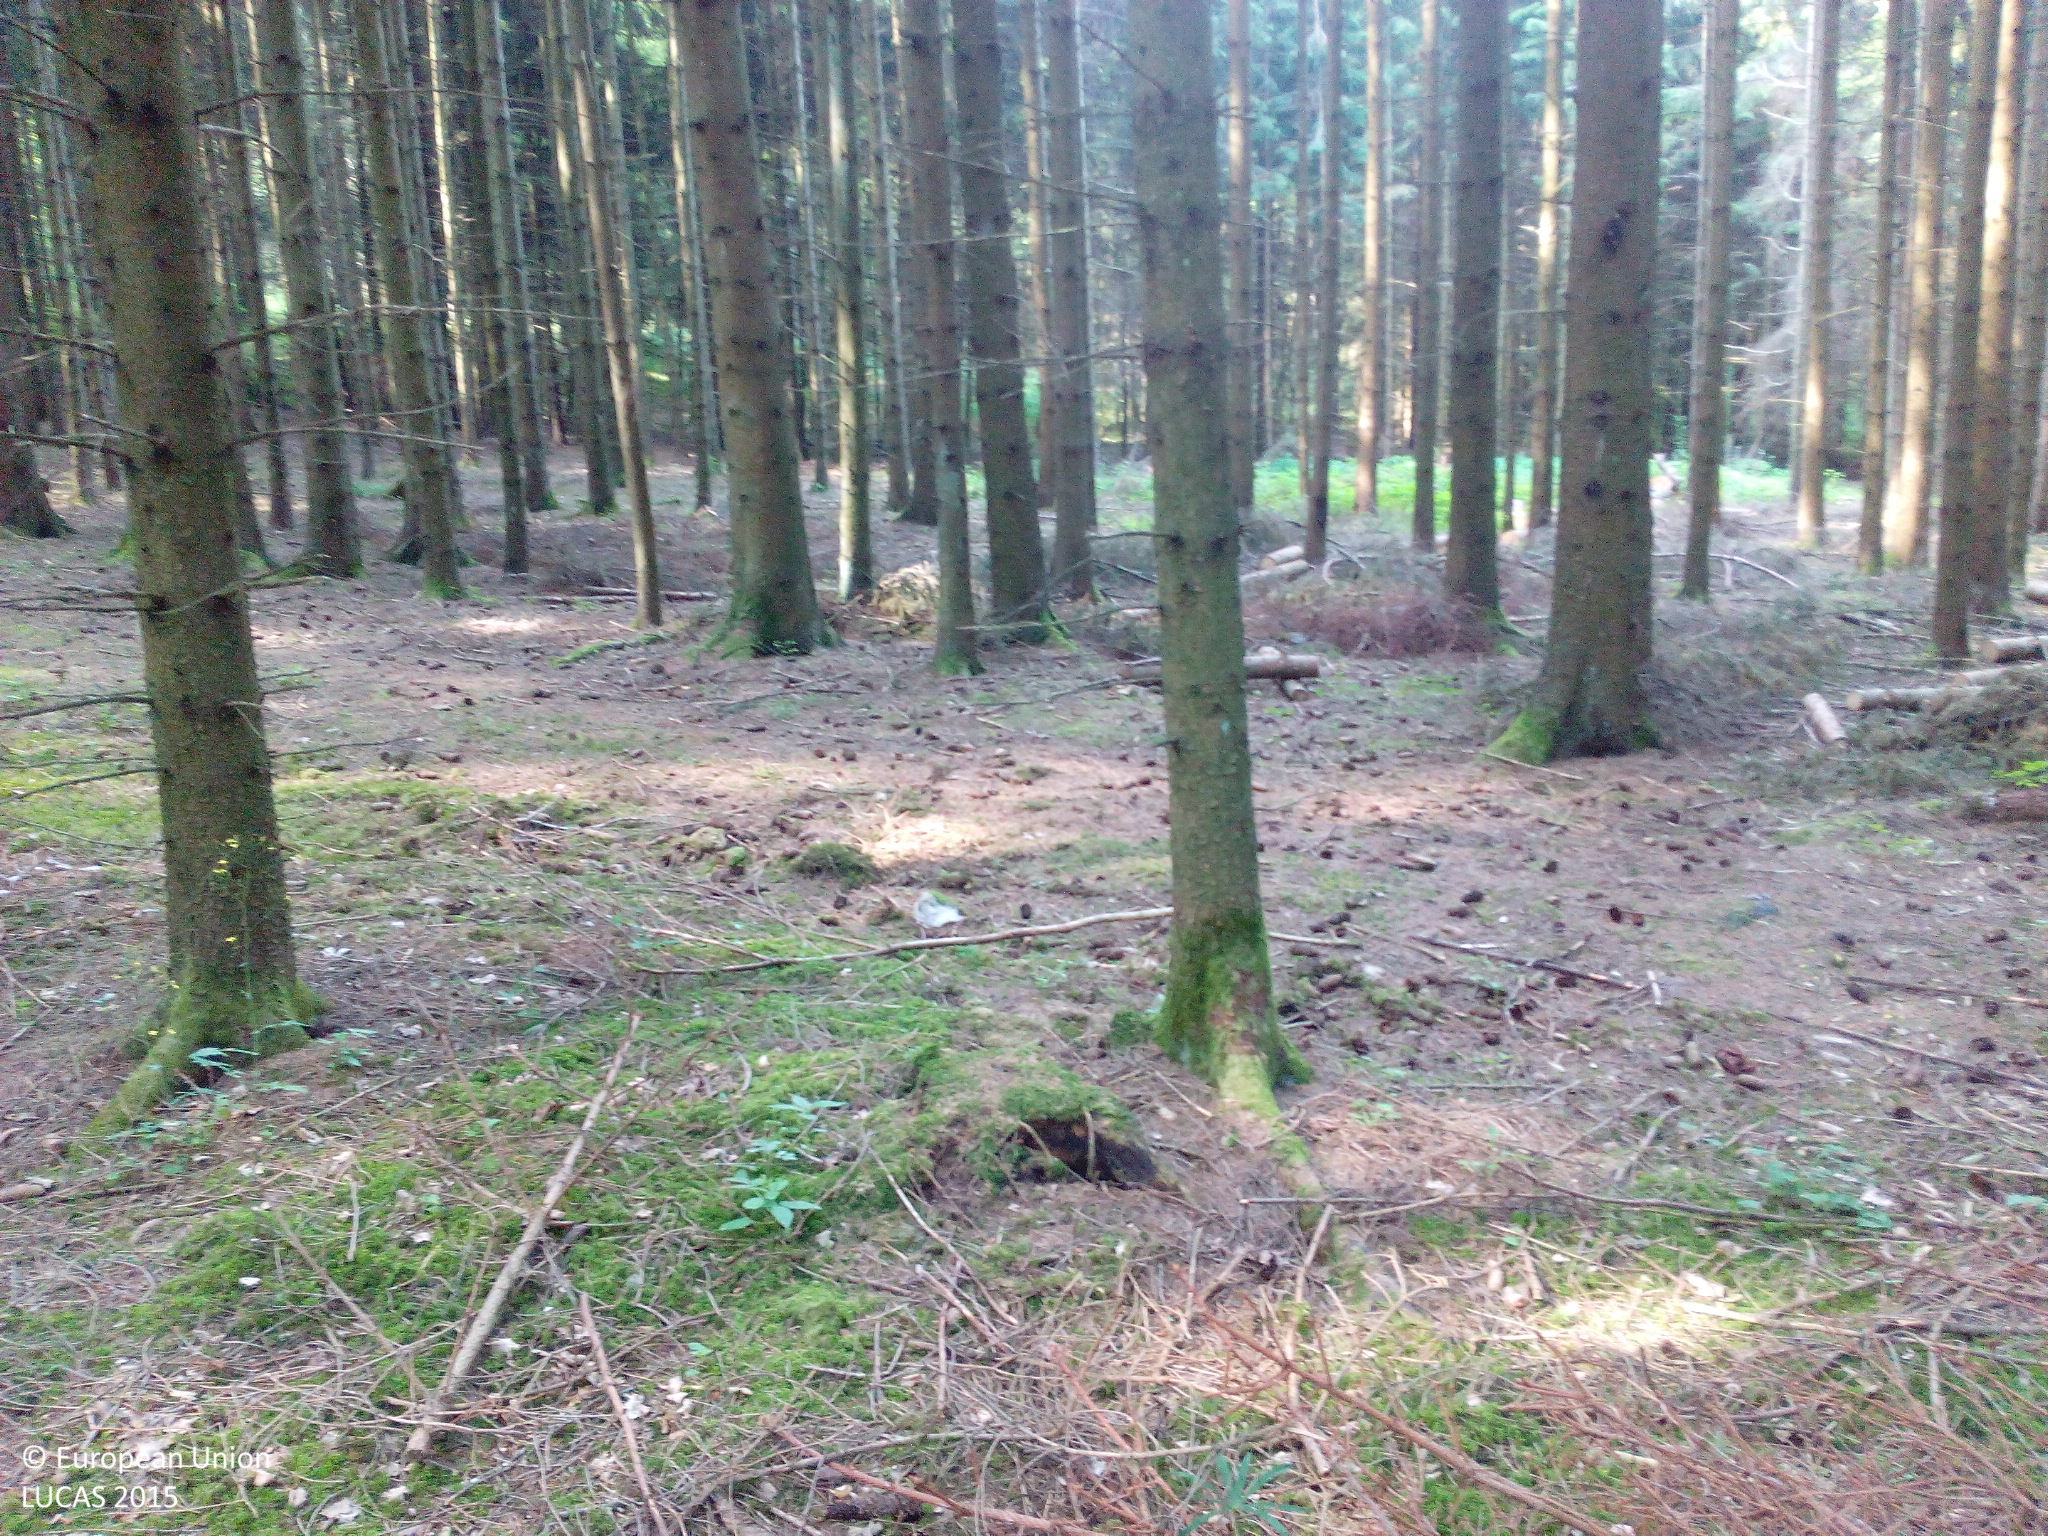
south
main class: Woodland
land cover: Spruce dominated coniferous woodland
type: hemiboreal forest and nemoral coniferous forest and mixed broadleaved-coniferous forest
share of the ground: > 75 %
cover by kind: coniferous forest trees 95 %, broadleaved forest trees 5 %
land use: Forestry
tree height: > 5 m
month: July
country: DE
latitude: 48.1854
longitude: 9.3144
